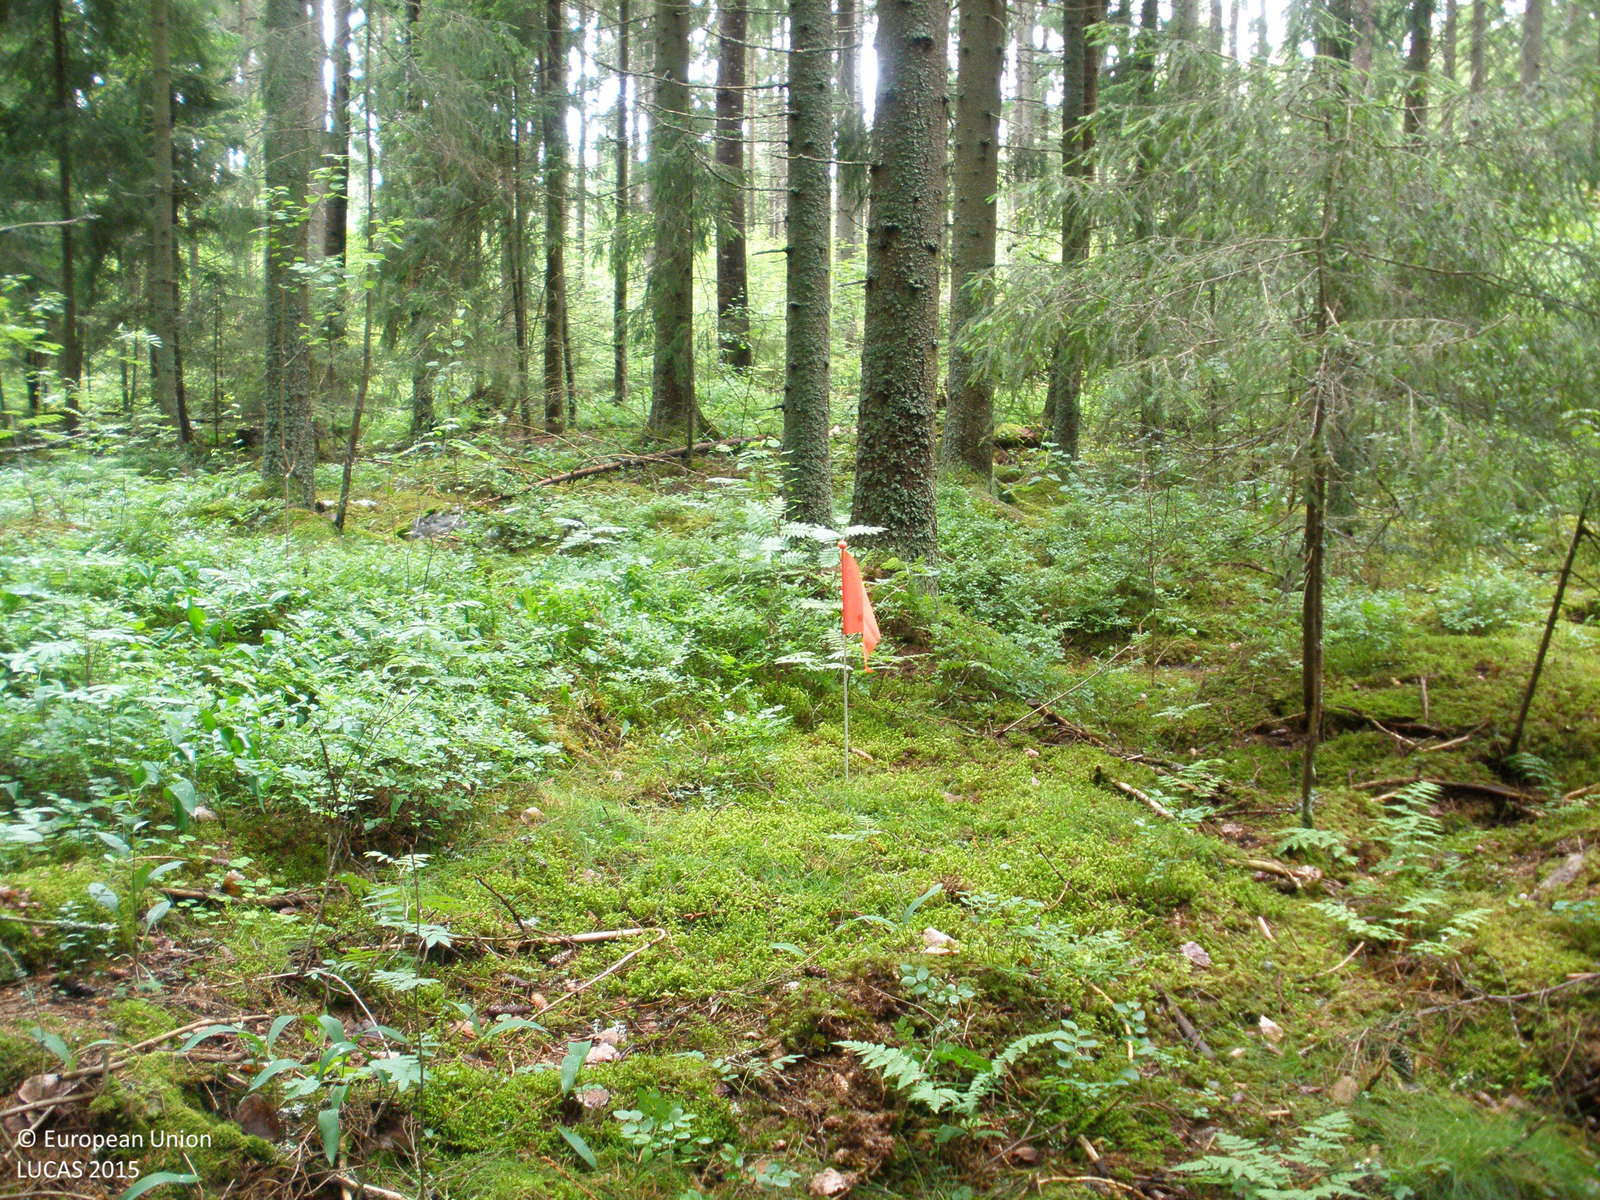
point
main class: Woodland
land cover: Spruce dominated coniferous woodland
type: boreal forest
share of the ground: > 75 %
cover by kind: coniferous forest trees 80 %, herbaceous plants 10 %, broadleaved forest trees 5 %, lichens and mosses 5 %
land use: Forestry
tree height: > 5 m
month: July
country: FI
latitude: 61.3392
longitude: 23.7097
